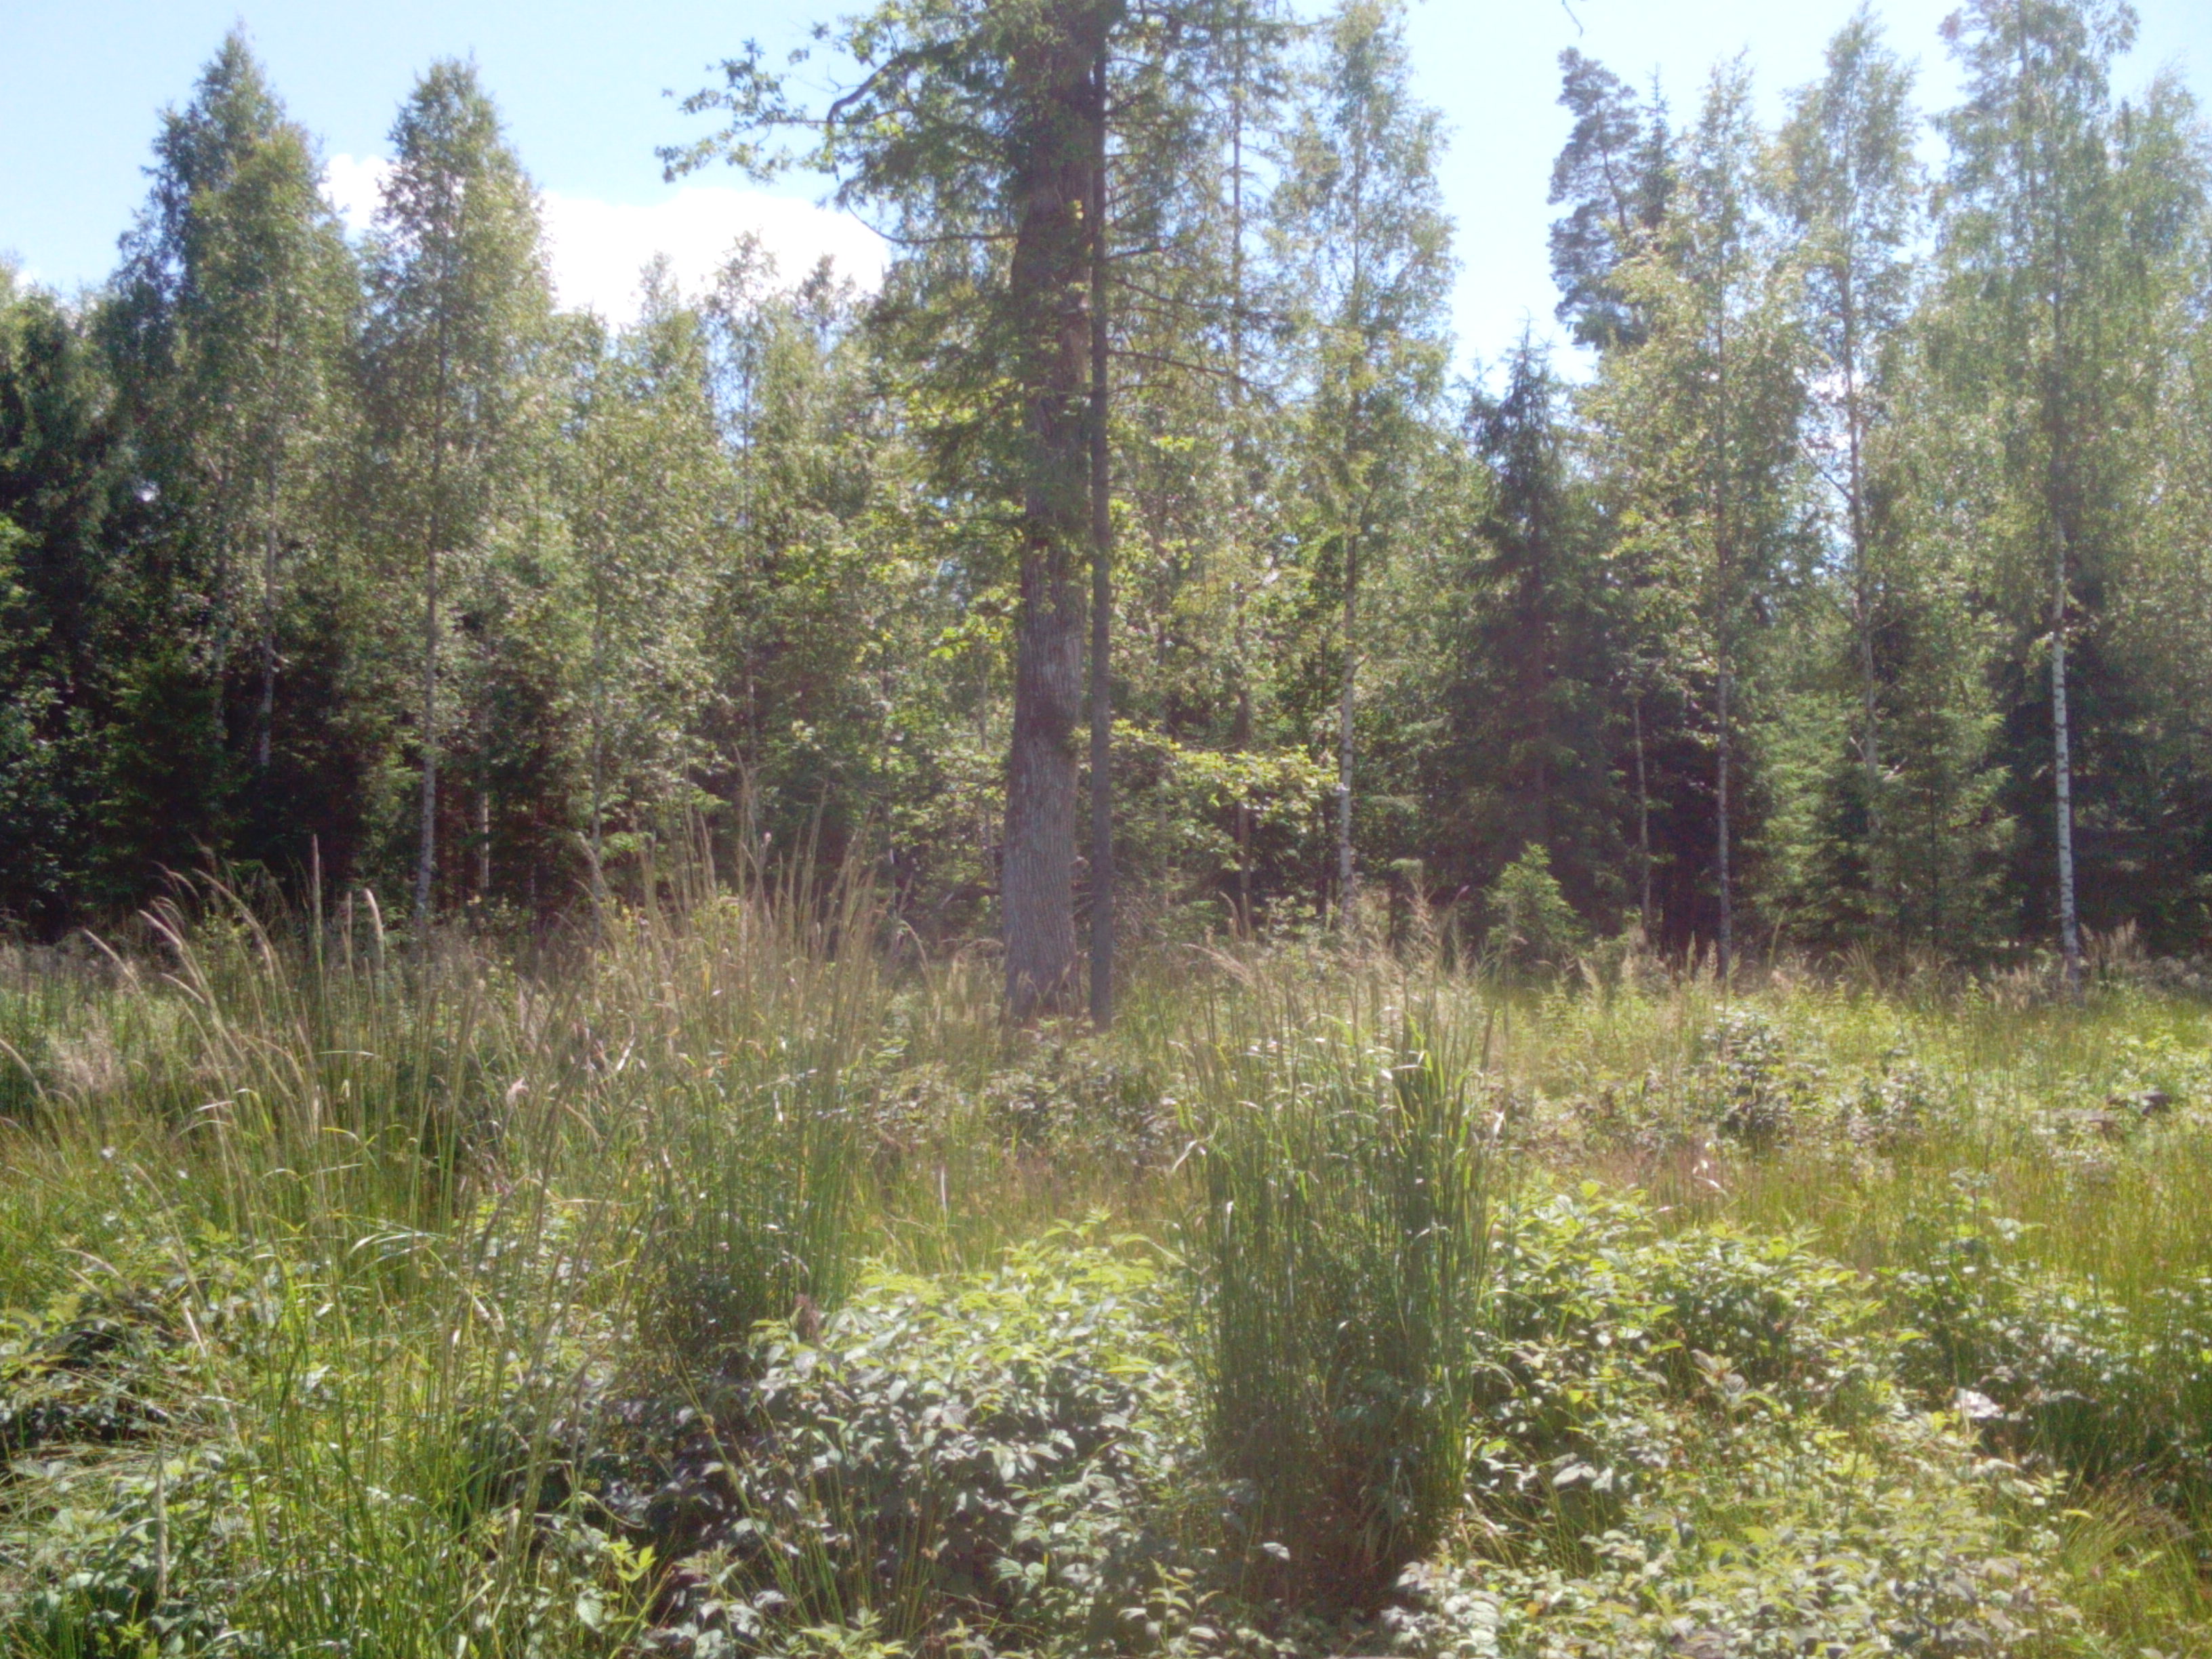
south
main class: Grassland
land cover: Grassland with sparse tree/shrub cover
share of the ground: > 75 %
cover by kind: herbaceous plants 85 %, shrubs 10 %, broadleaved forest trees 5 %
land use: Forestry
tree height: < 5 m
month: July
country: LV
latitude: 56.4027
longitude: 21.8274
